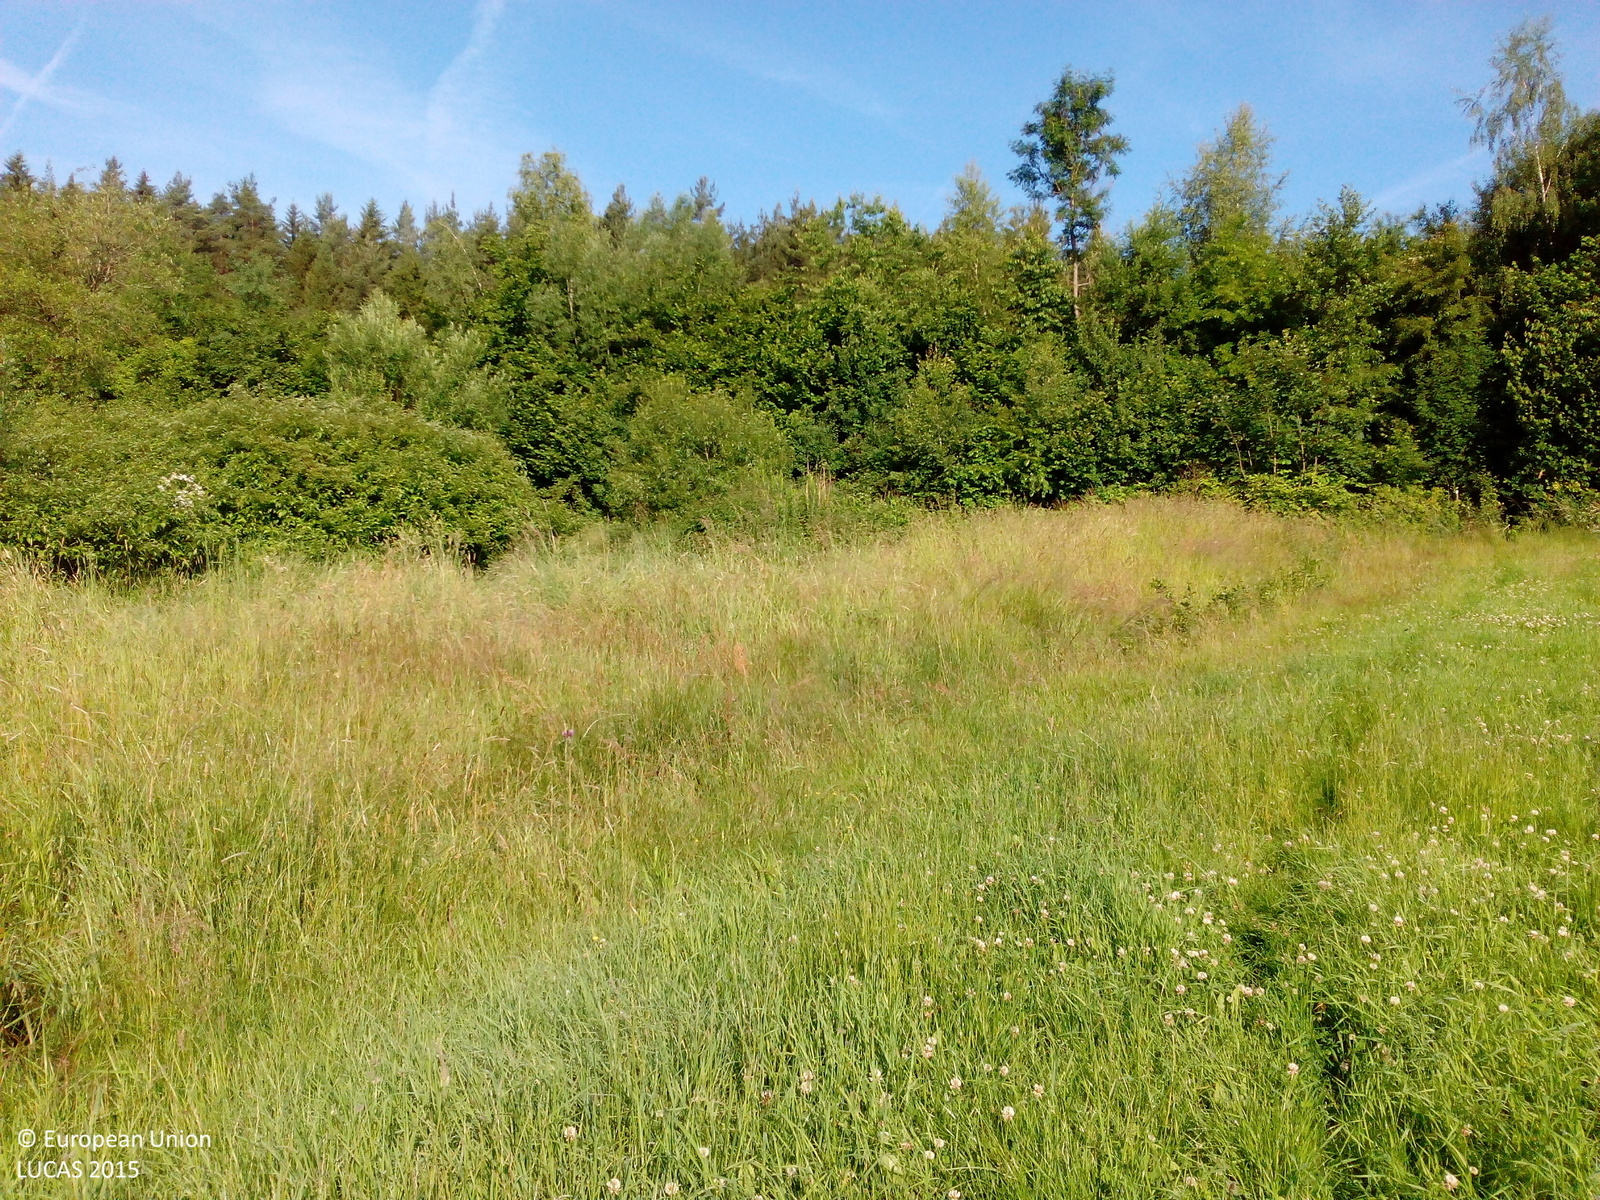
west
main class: Grassland
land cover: Grassland without tree/shrub cover
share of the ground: > 75 %
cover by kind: herbaceous plants 100 %
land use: Agriculture (excluding fallow land and kitchen gardens)
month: June
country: DE
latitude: 49.9974
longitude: 12.3852
